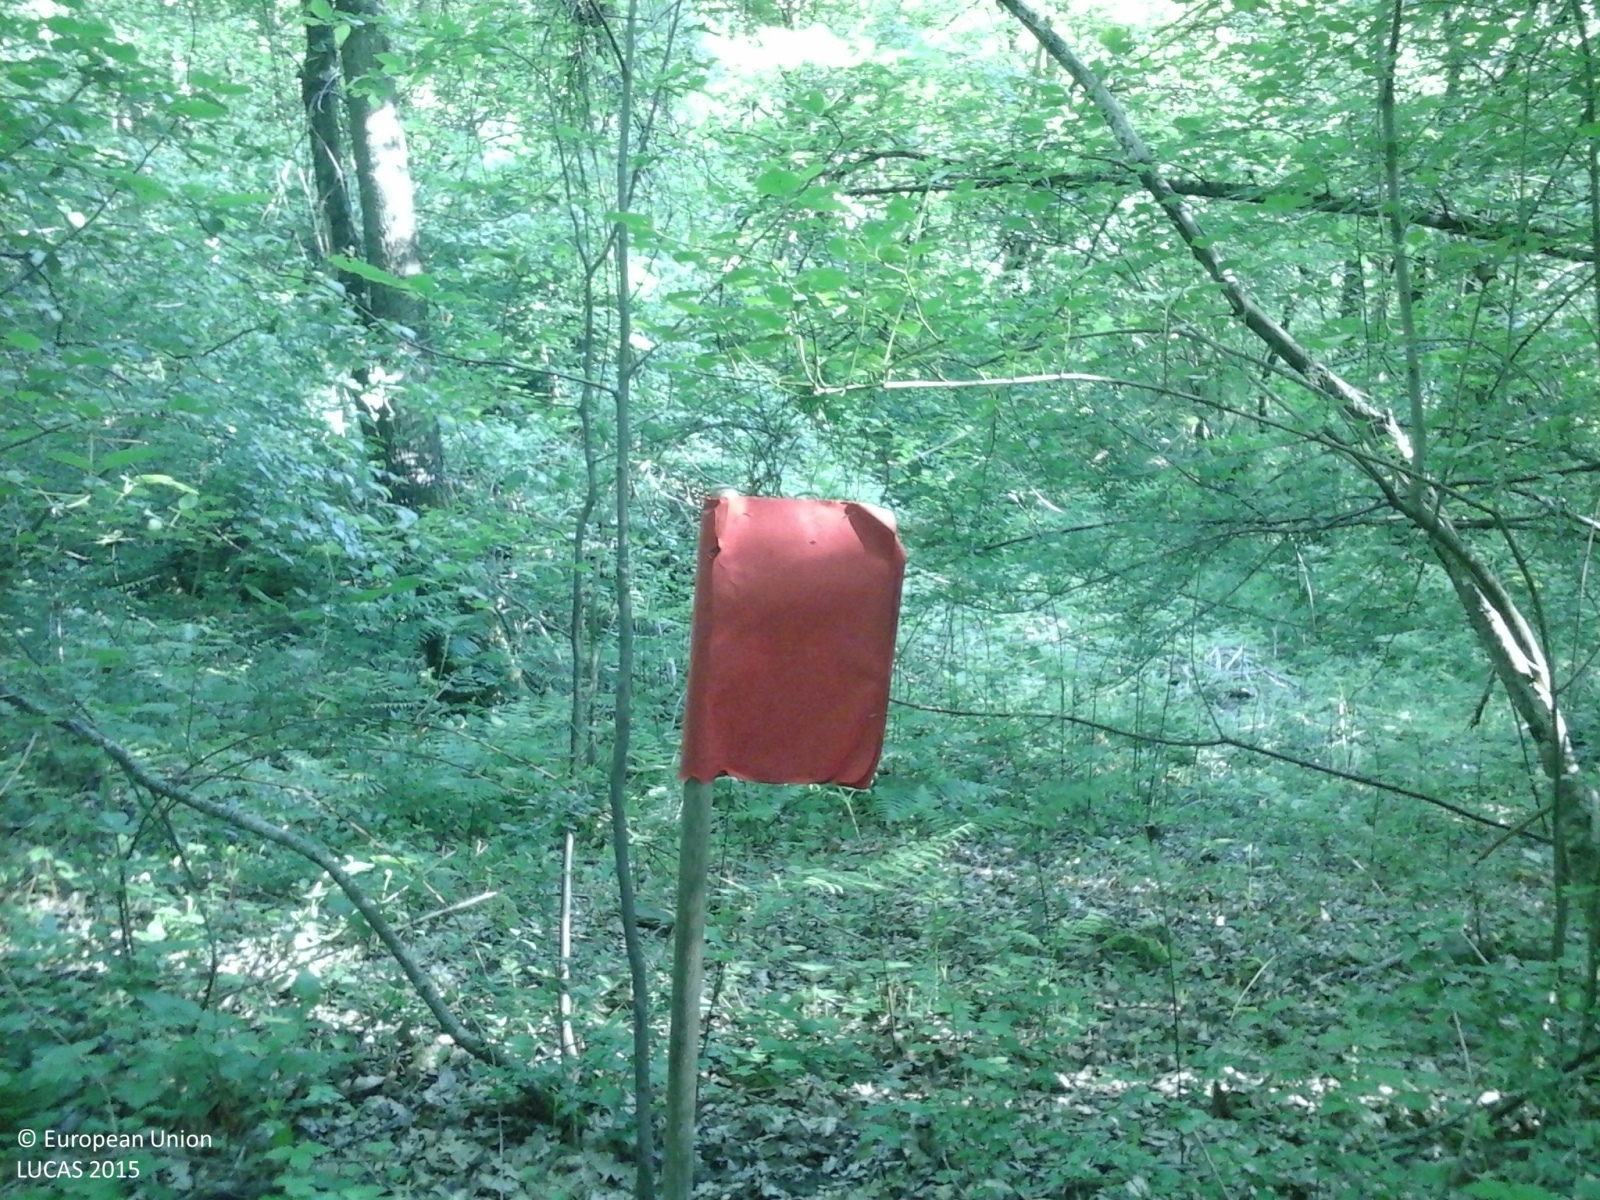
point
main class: Woodland
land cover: Broadleaved woodland
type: thermophilous deciduous forest
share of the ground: > 75 %
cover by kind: broadleaved forest trees 90 %, shrubs 10 %
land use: Forestry
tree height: > 5 m
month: May
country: IT
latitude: 44.5304
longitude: 9.6861
